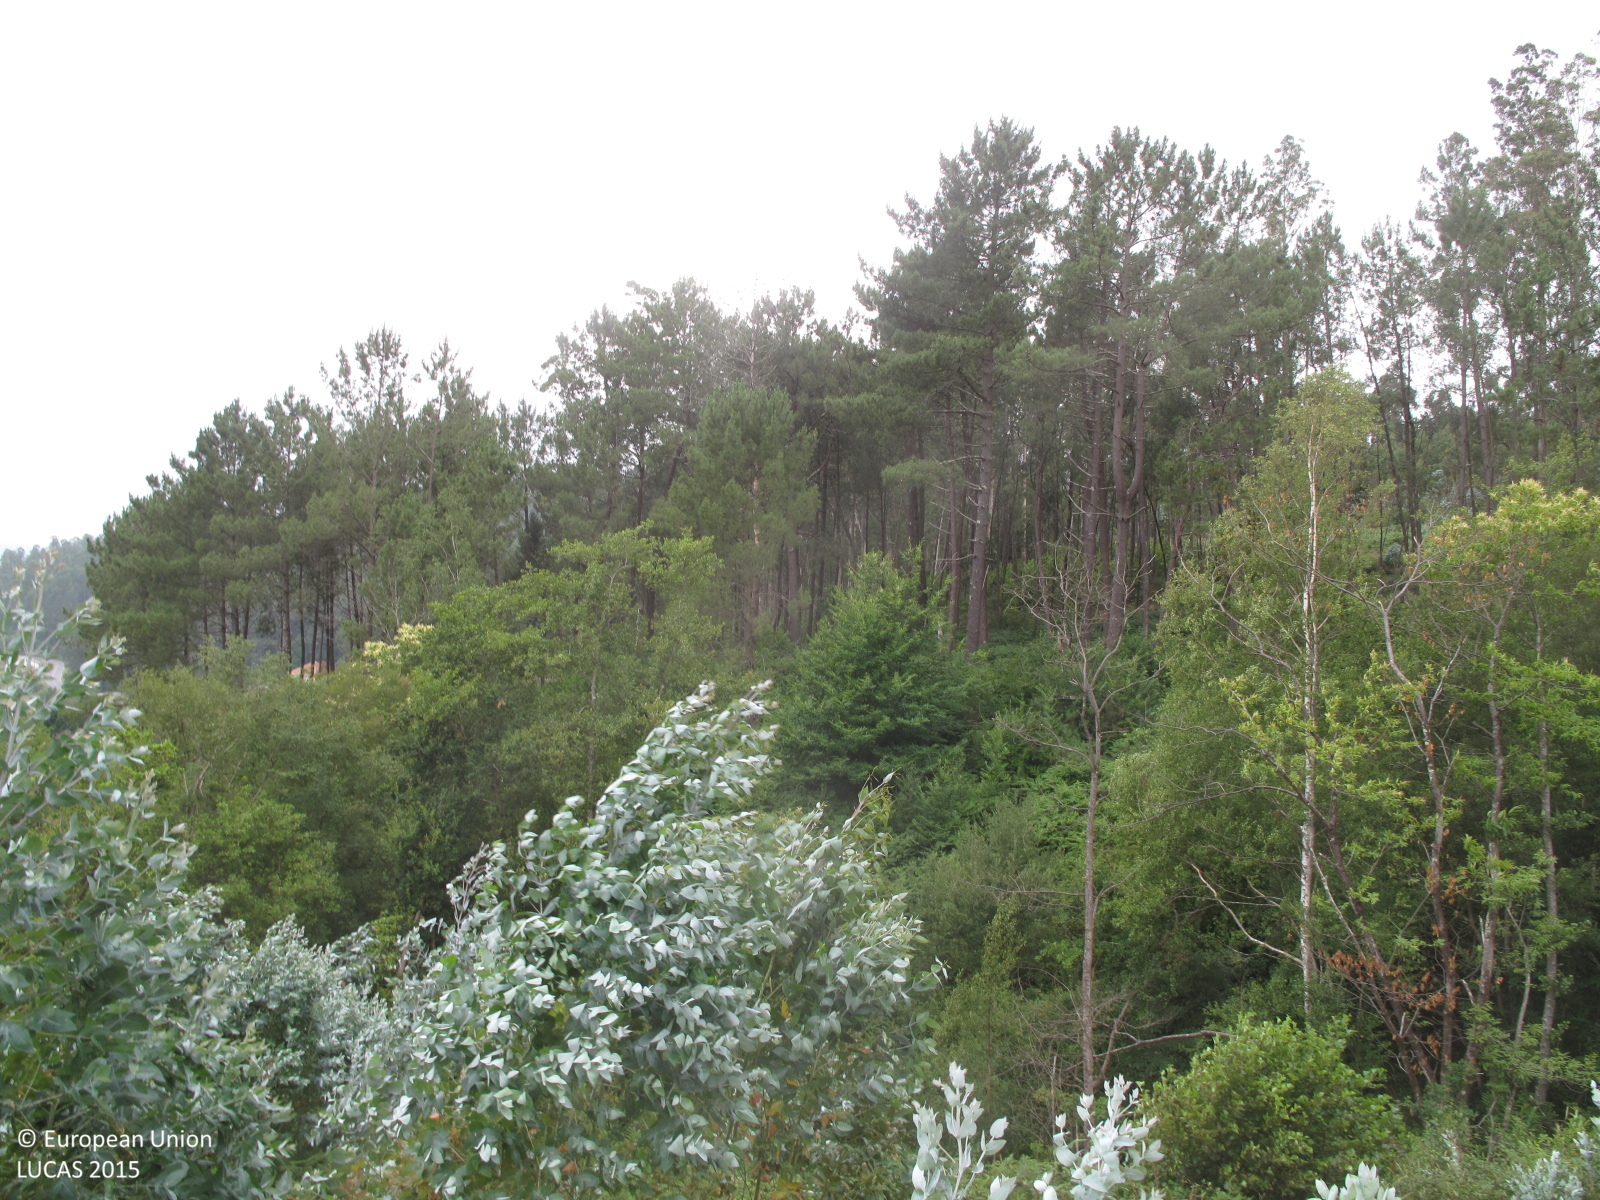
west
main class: Woodland
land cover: Broadleaved woodland
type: exotic forest
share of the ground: 10 - 25 %
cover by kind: herbaceous plants 40 %, broadleaved forest trees 20 %, shrubs 20 %, unconsolidated bare surface 20 %
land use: Forestry
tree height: < 5 m
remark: Clear cut
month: July
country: ES
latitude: 43.3824
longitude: -8.1326
